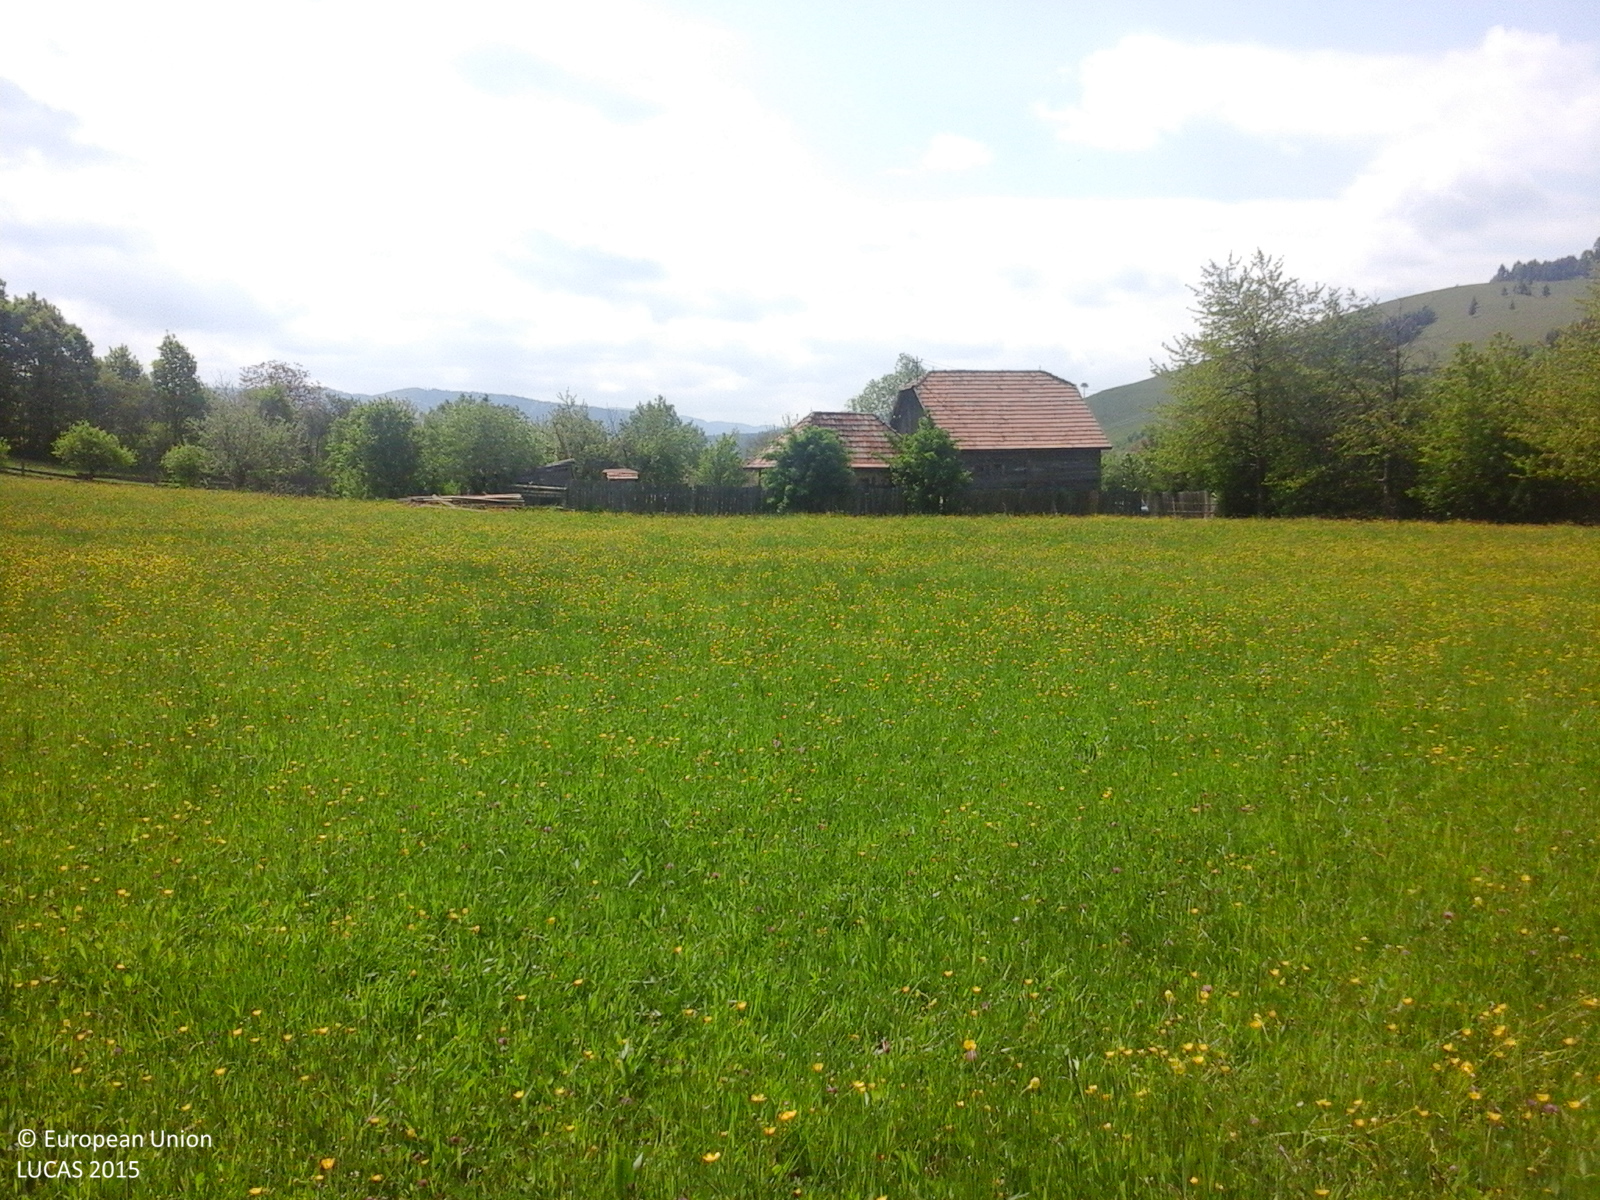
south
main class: Grassland
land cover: Grassland without tree/shrub cover
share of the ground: > 75 %
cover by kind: herbaceous plants 100 %
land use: Agriculture (excluding fallow land and kitchen gardens)
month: May
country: RO
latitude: 45.9761
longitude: 26.2702
